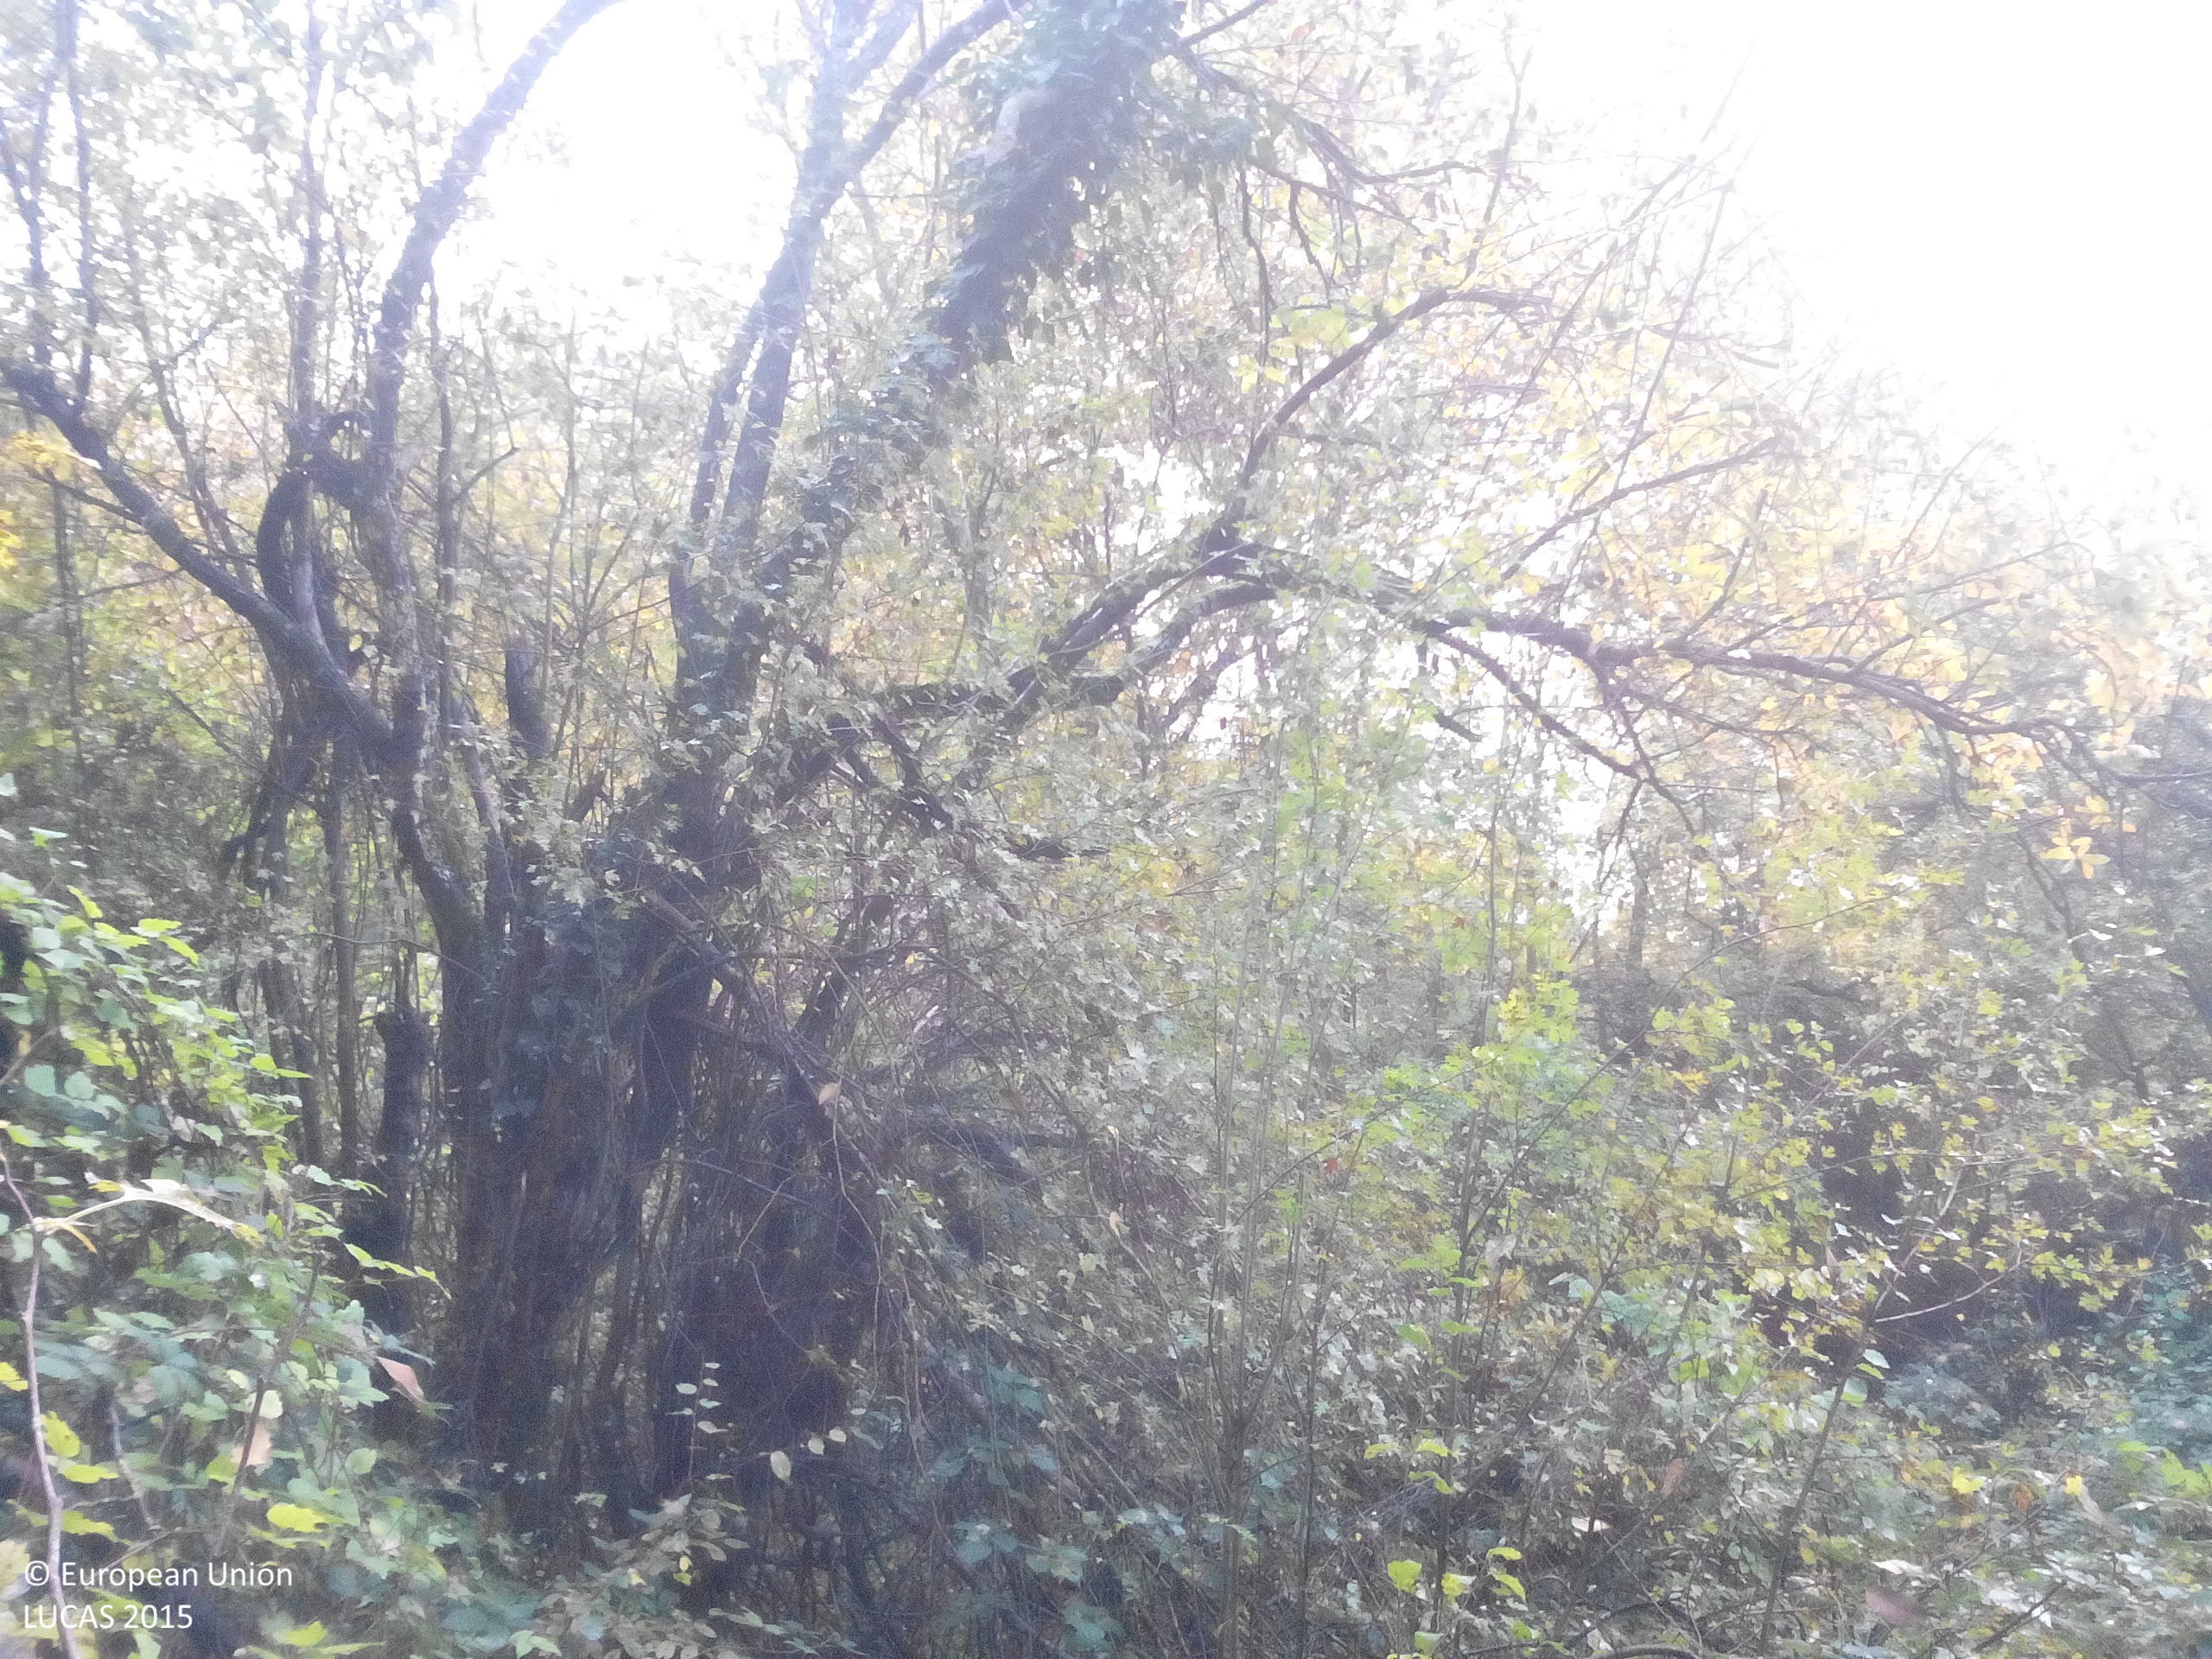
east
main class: Woodland
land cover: Broadleaved woodland
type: beech forest
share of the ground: > 75 %
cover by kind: broadleaved forest trees 95 %, shrubs 5 %
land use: Forestry
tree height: > 5 m
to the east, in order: Broadleaved woodland
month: October
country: BG
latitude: 43.0218
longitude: 24.4498
